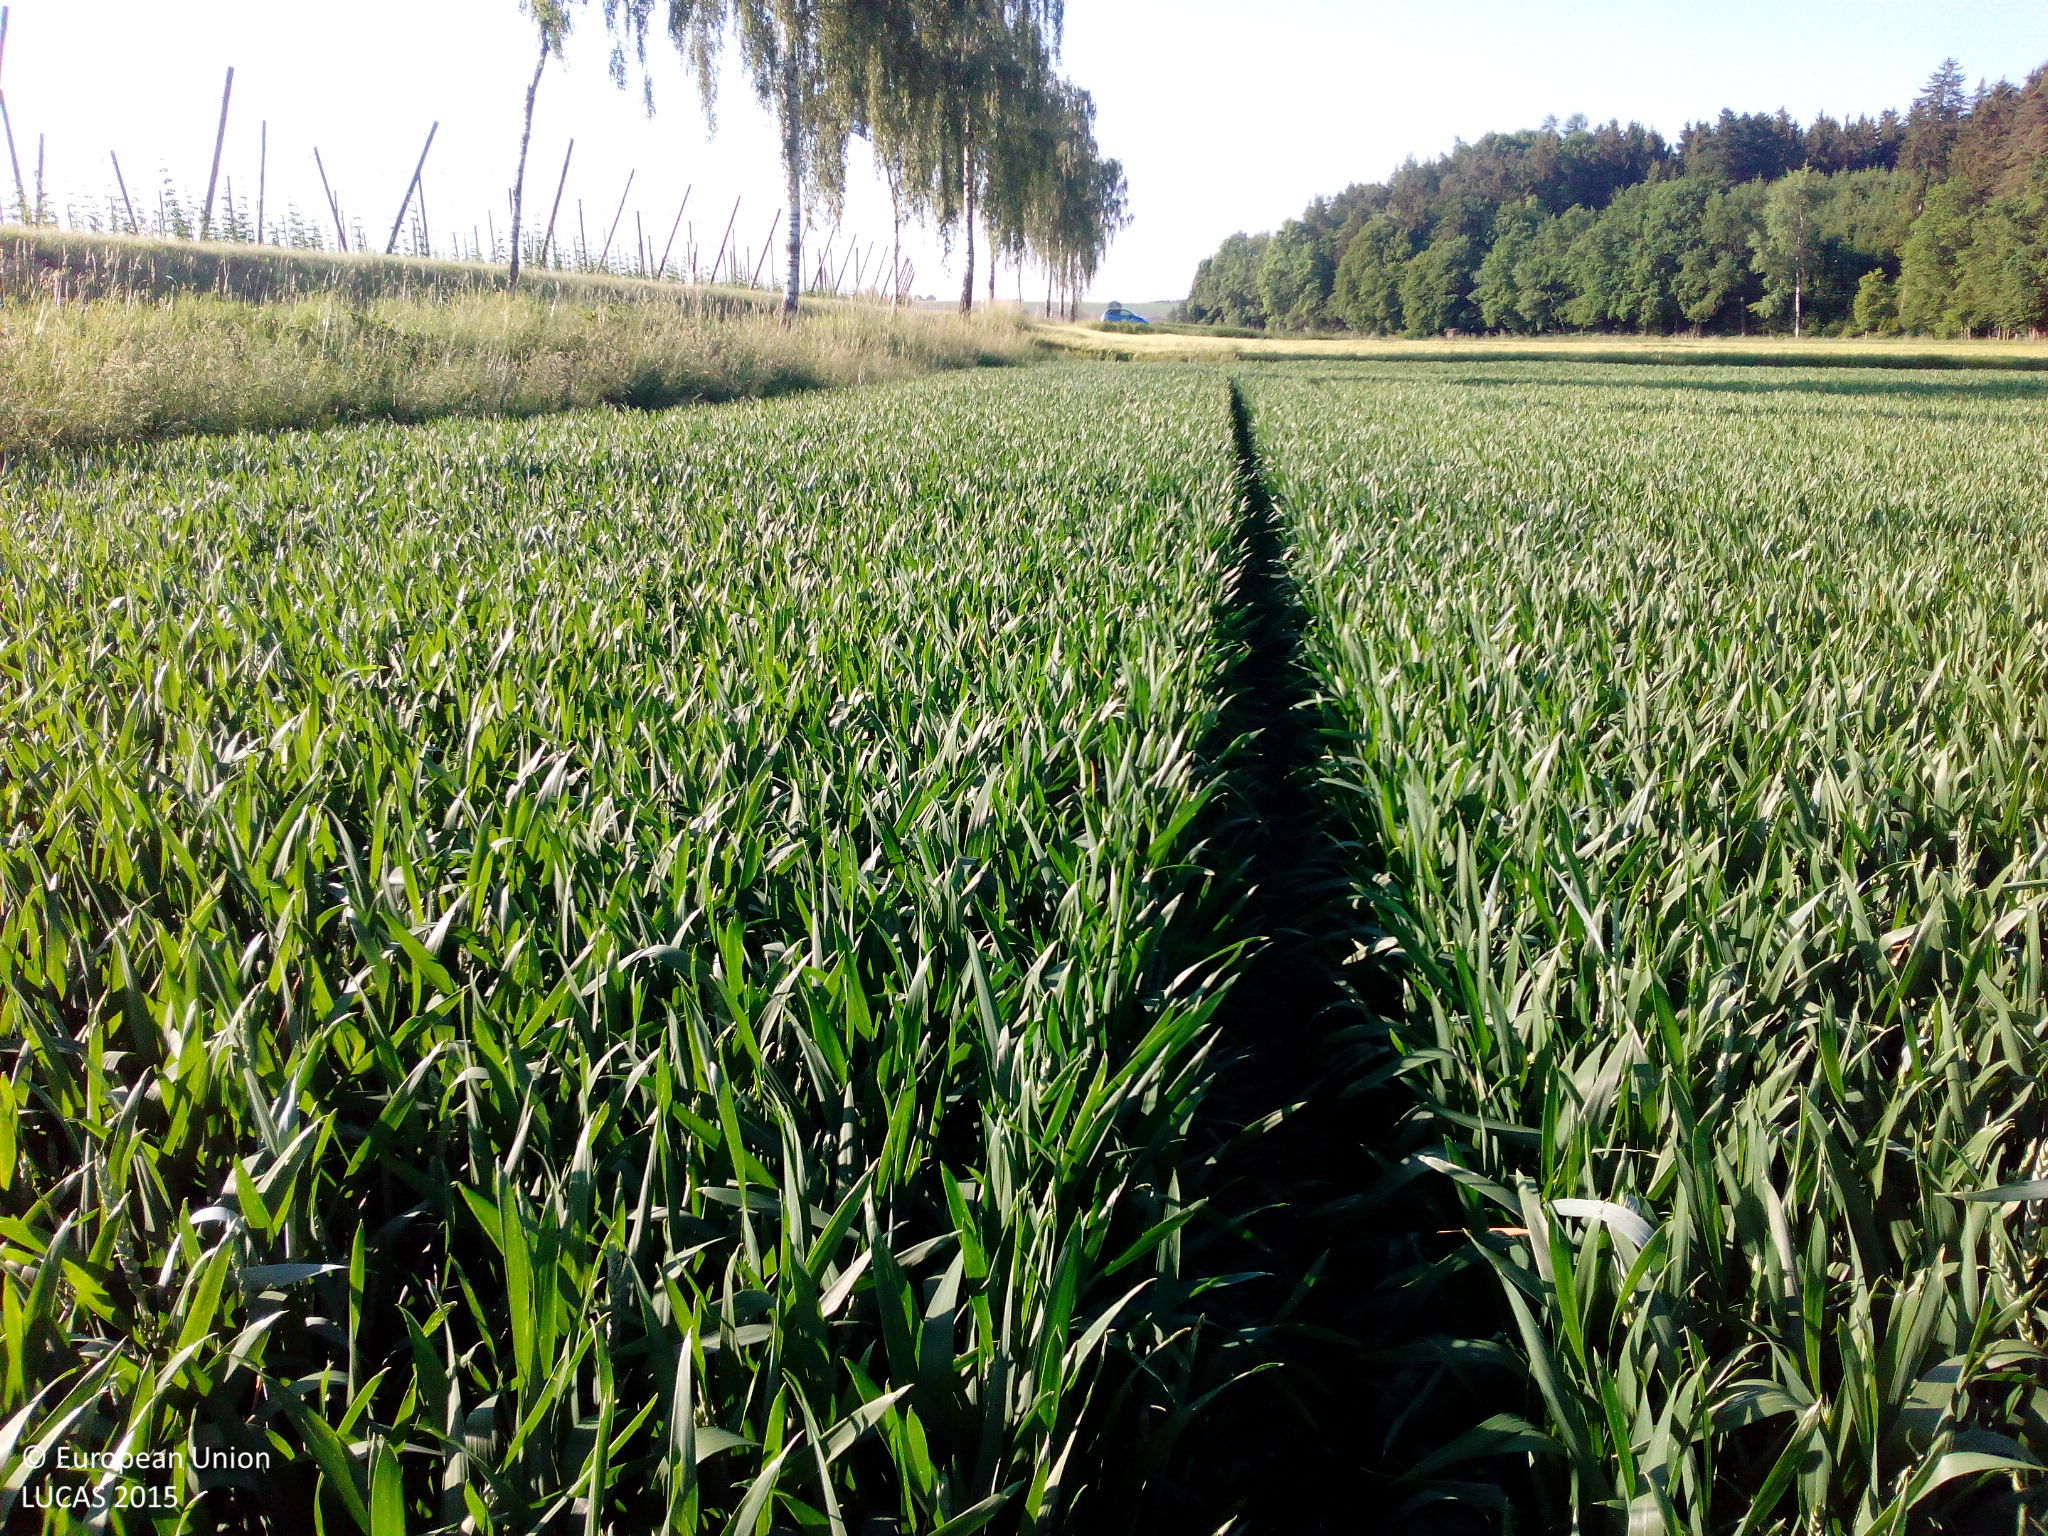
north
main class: Cropland
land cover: Common wheat
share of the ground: > 75 %
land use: Agriculture (excluding fallow land and kitchen gardens)
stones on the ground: < 10 %
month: June
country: DE
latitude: 48.6389
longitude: 11.9127
